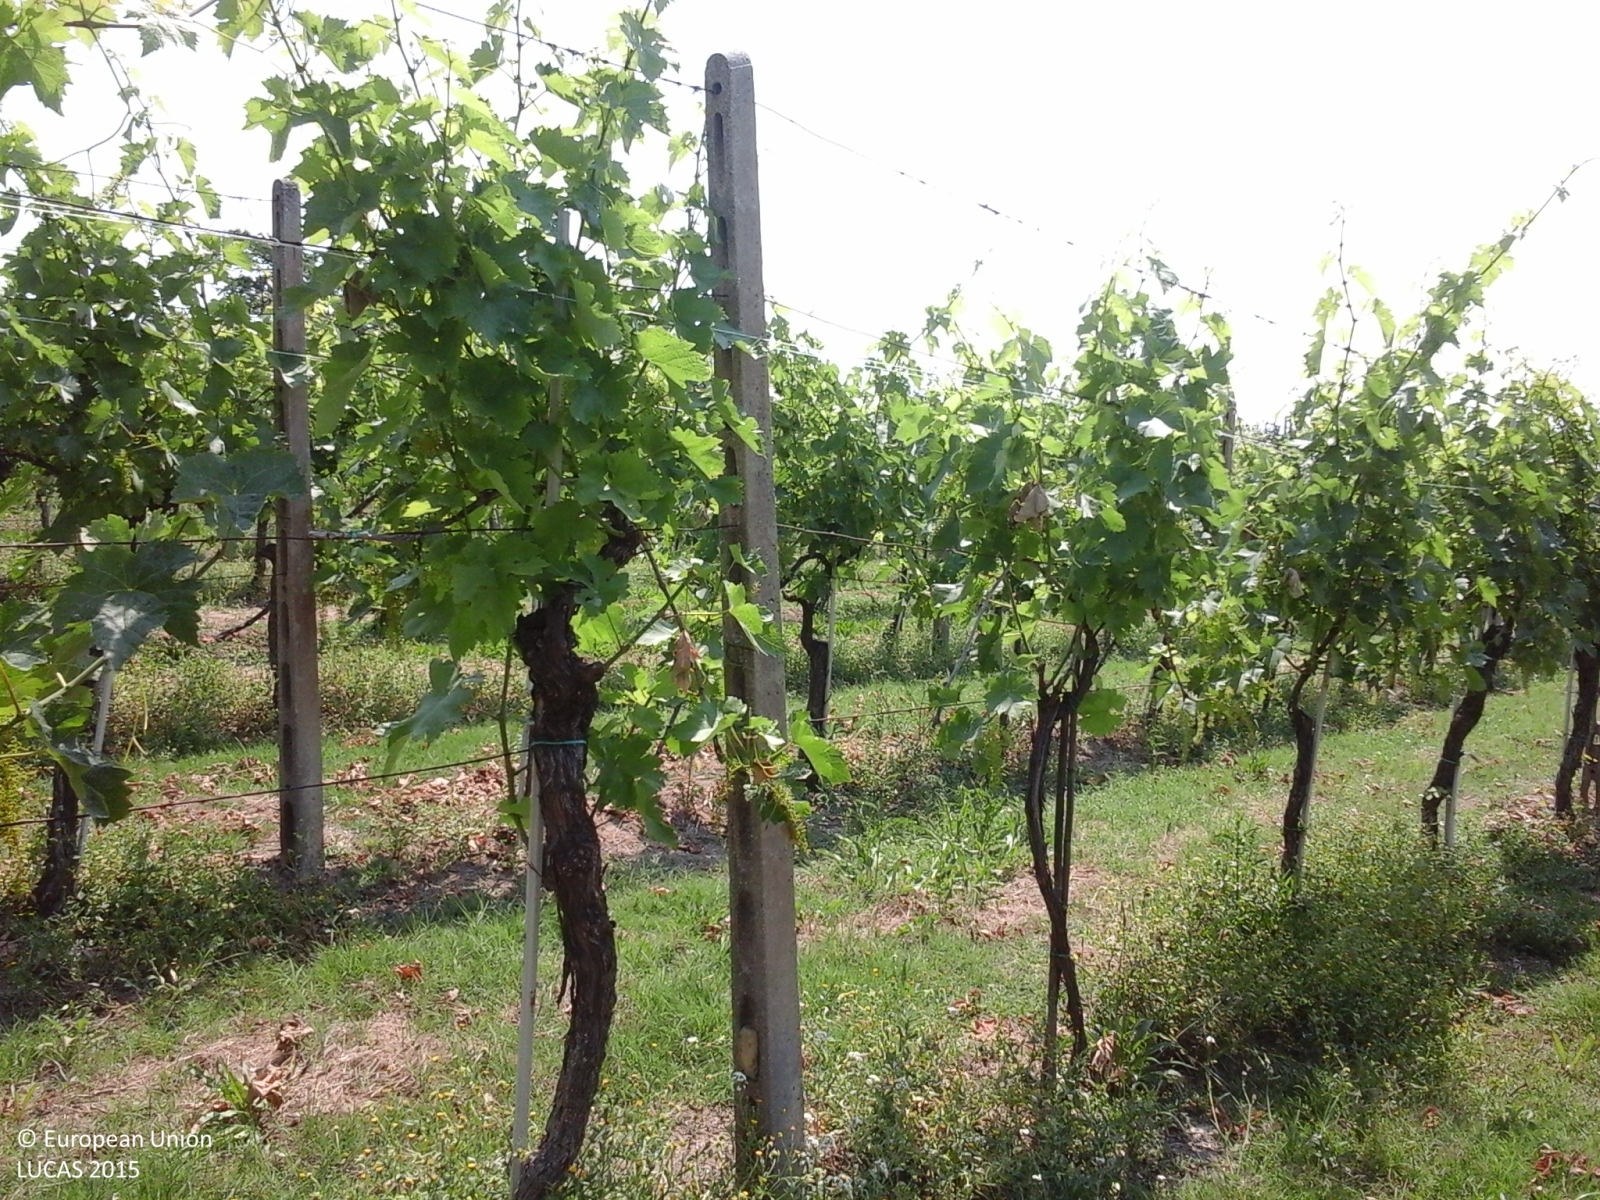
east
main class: Cropland
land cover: Vineyards
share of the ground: 50 - 75 %
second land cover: Spontaneously vegetated surfaces
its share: > 75 %
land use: Agriculture (excluding fallow land and kitchen gardens)
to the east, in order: Vineyards; Spontaneously vegetated surfaces; Grass margins; Tracks; Abandoned hedges; Grassland with sparse tree/shrub cover; Artificial constructions in urban areas
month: June
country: IT
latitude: 43.2810
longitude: 13.4785
